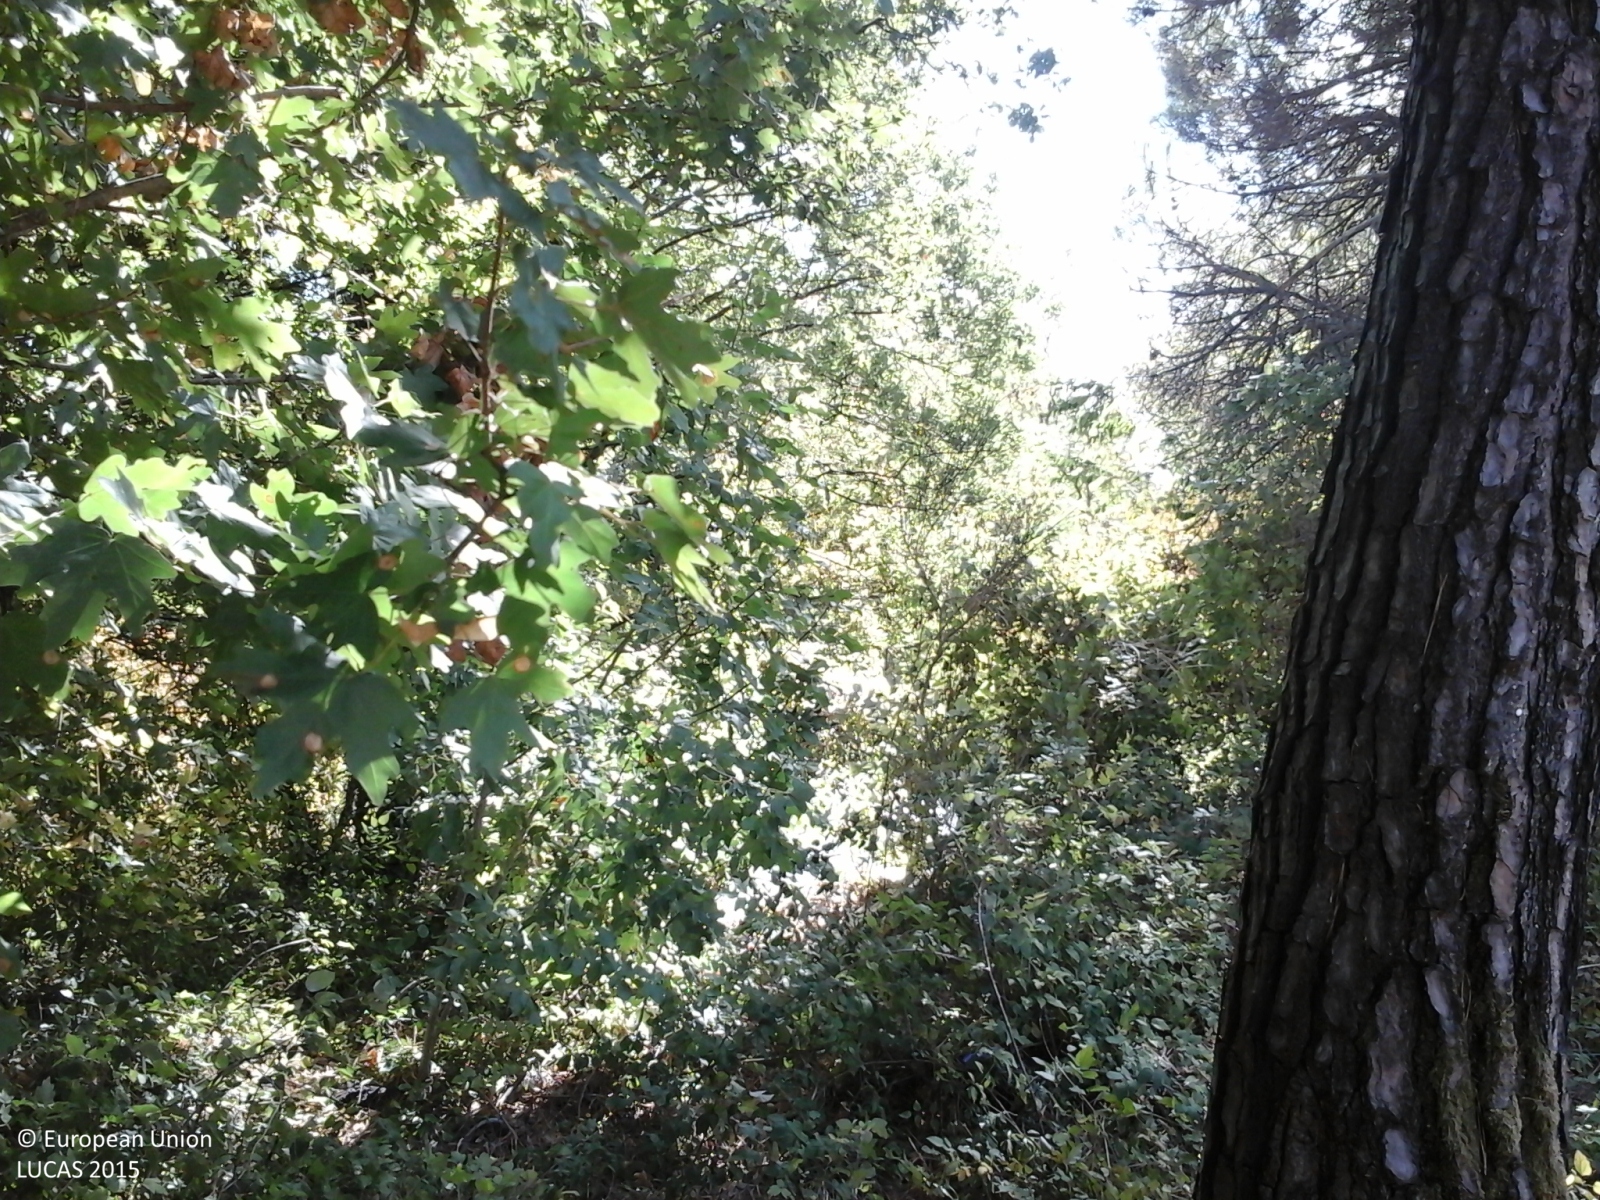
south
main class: Woodland
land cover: Broadleaved woodland
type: thermophilous deciduous forest
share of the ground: > 75 %
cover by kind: broadleaved forest trees 90 %, shrubs 10 %
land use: Forestry
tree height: > 5 m
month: September
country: IT
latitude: 43.2283
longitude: 12.0994
